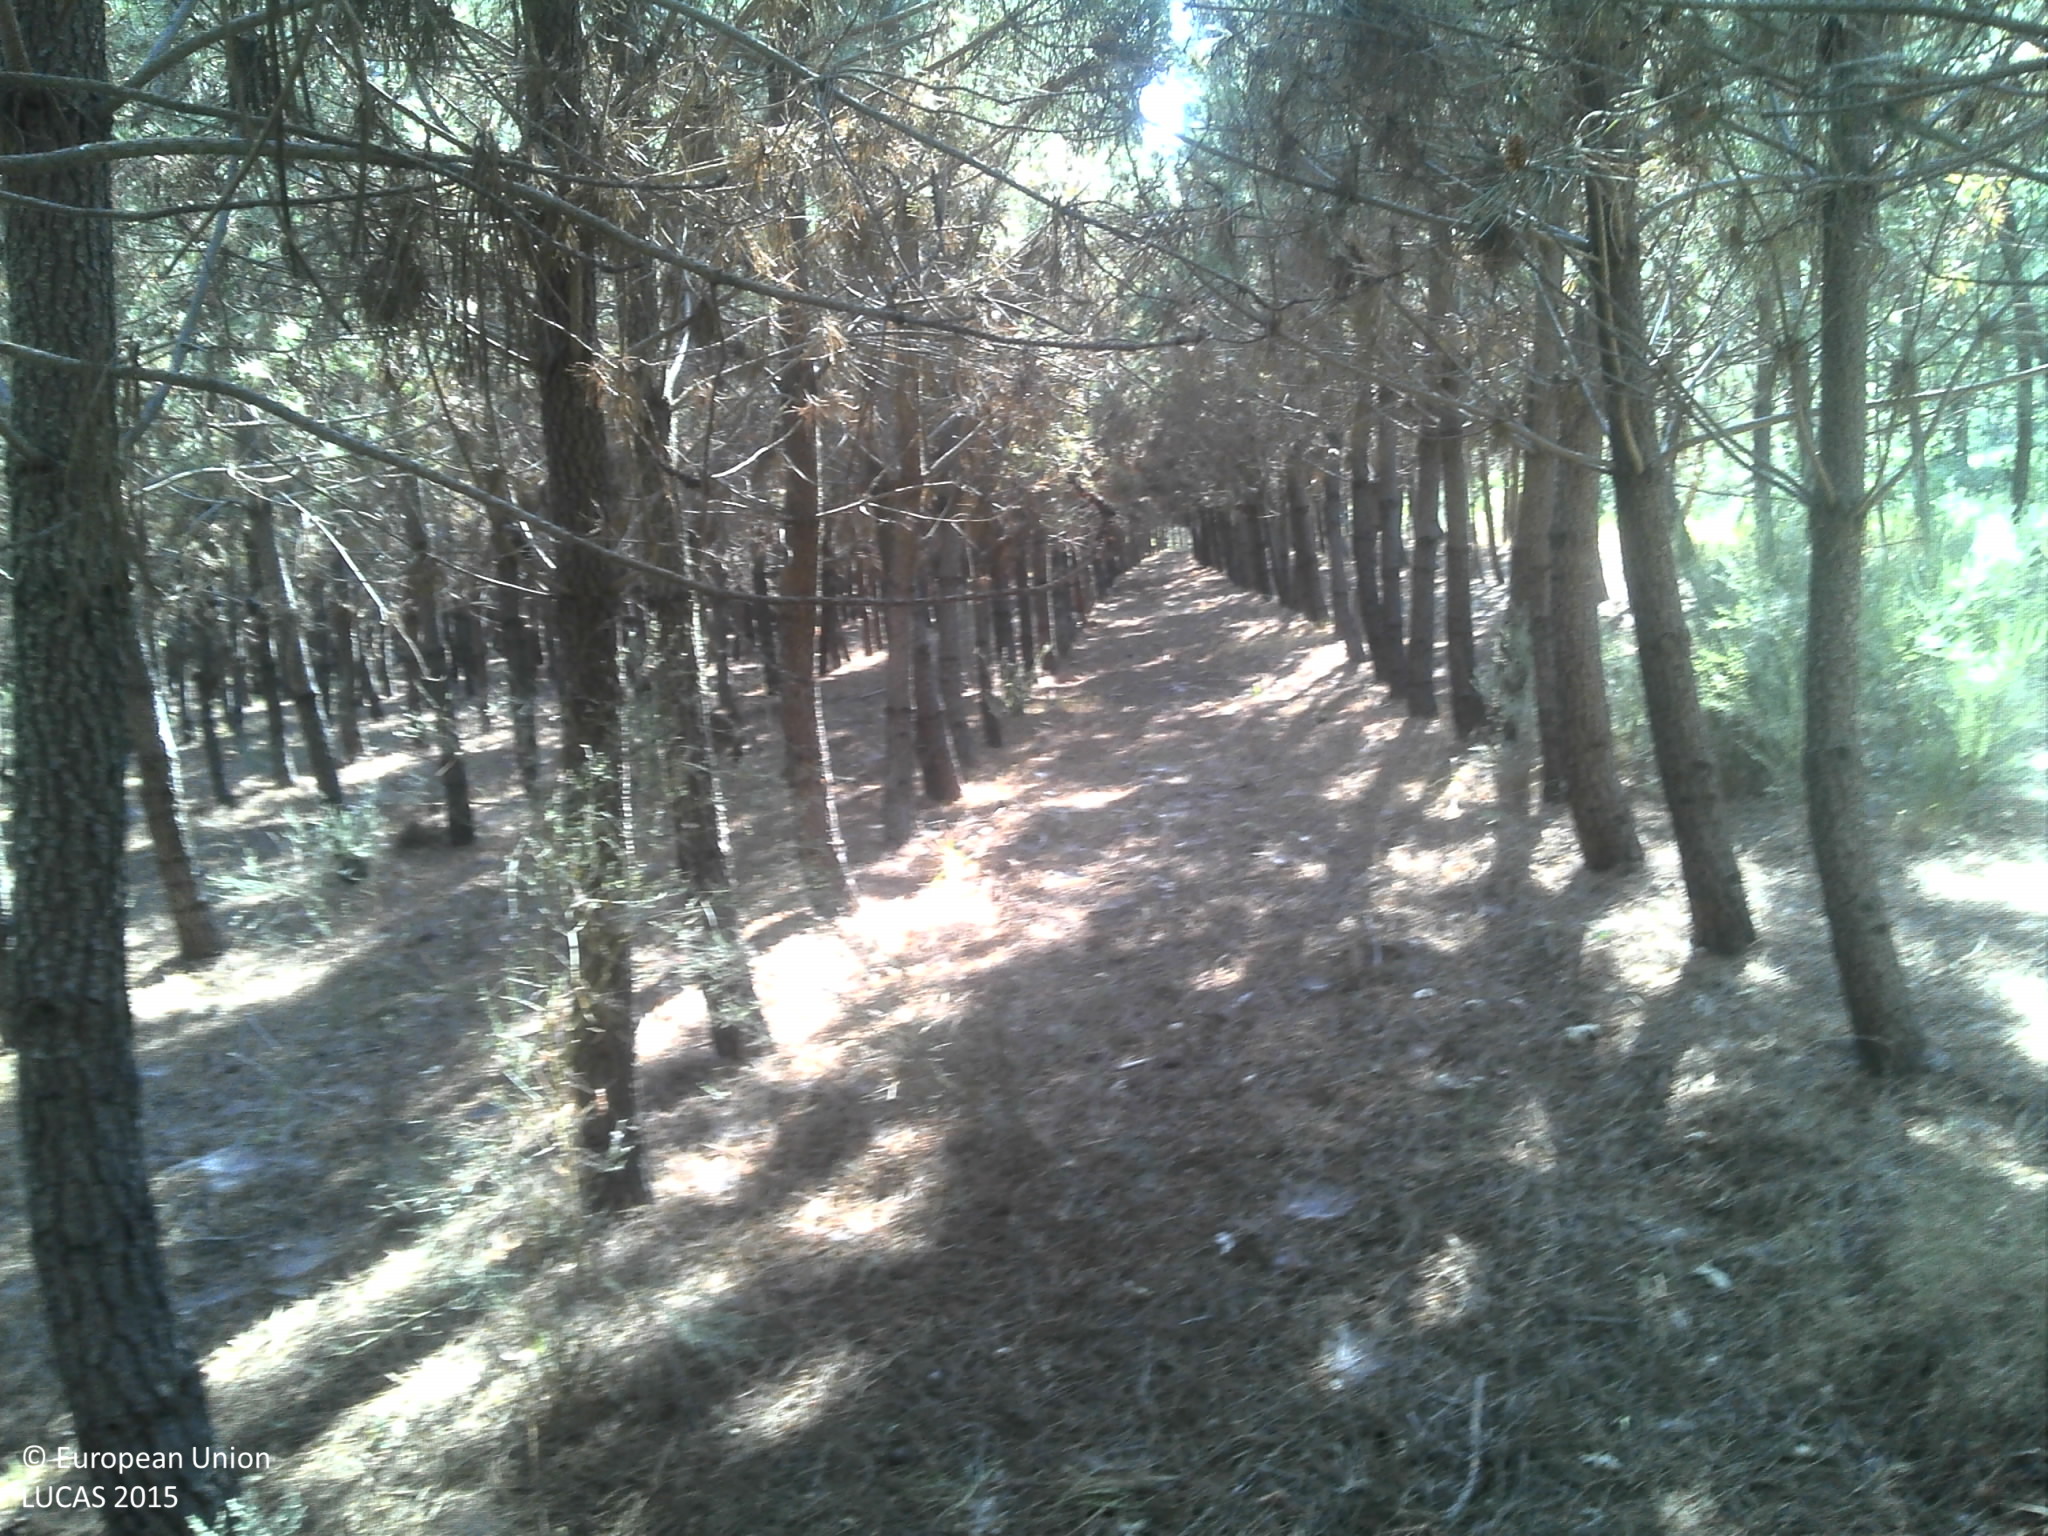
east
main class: Woodland
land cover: Pine dominated coniferous woodland
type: coniferous forest of the mediterranean region
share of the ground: 50 - 75 %
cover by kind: coniferous forest trees 75 %, unconsolidated bare surface 20 %, herbaceous plants 5 %
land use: Forestry
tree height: > 5 m
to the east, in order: Pine dominated coniferous woodland; Other bare soil; Shrubland with sparse tree cover; Broadleaved woodland; Tracks; Shrubland with sparse tree cover; Broadleaved woodland
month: June
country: PT
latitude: 40.3798
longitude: -6.9752
